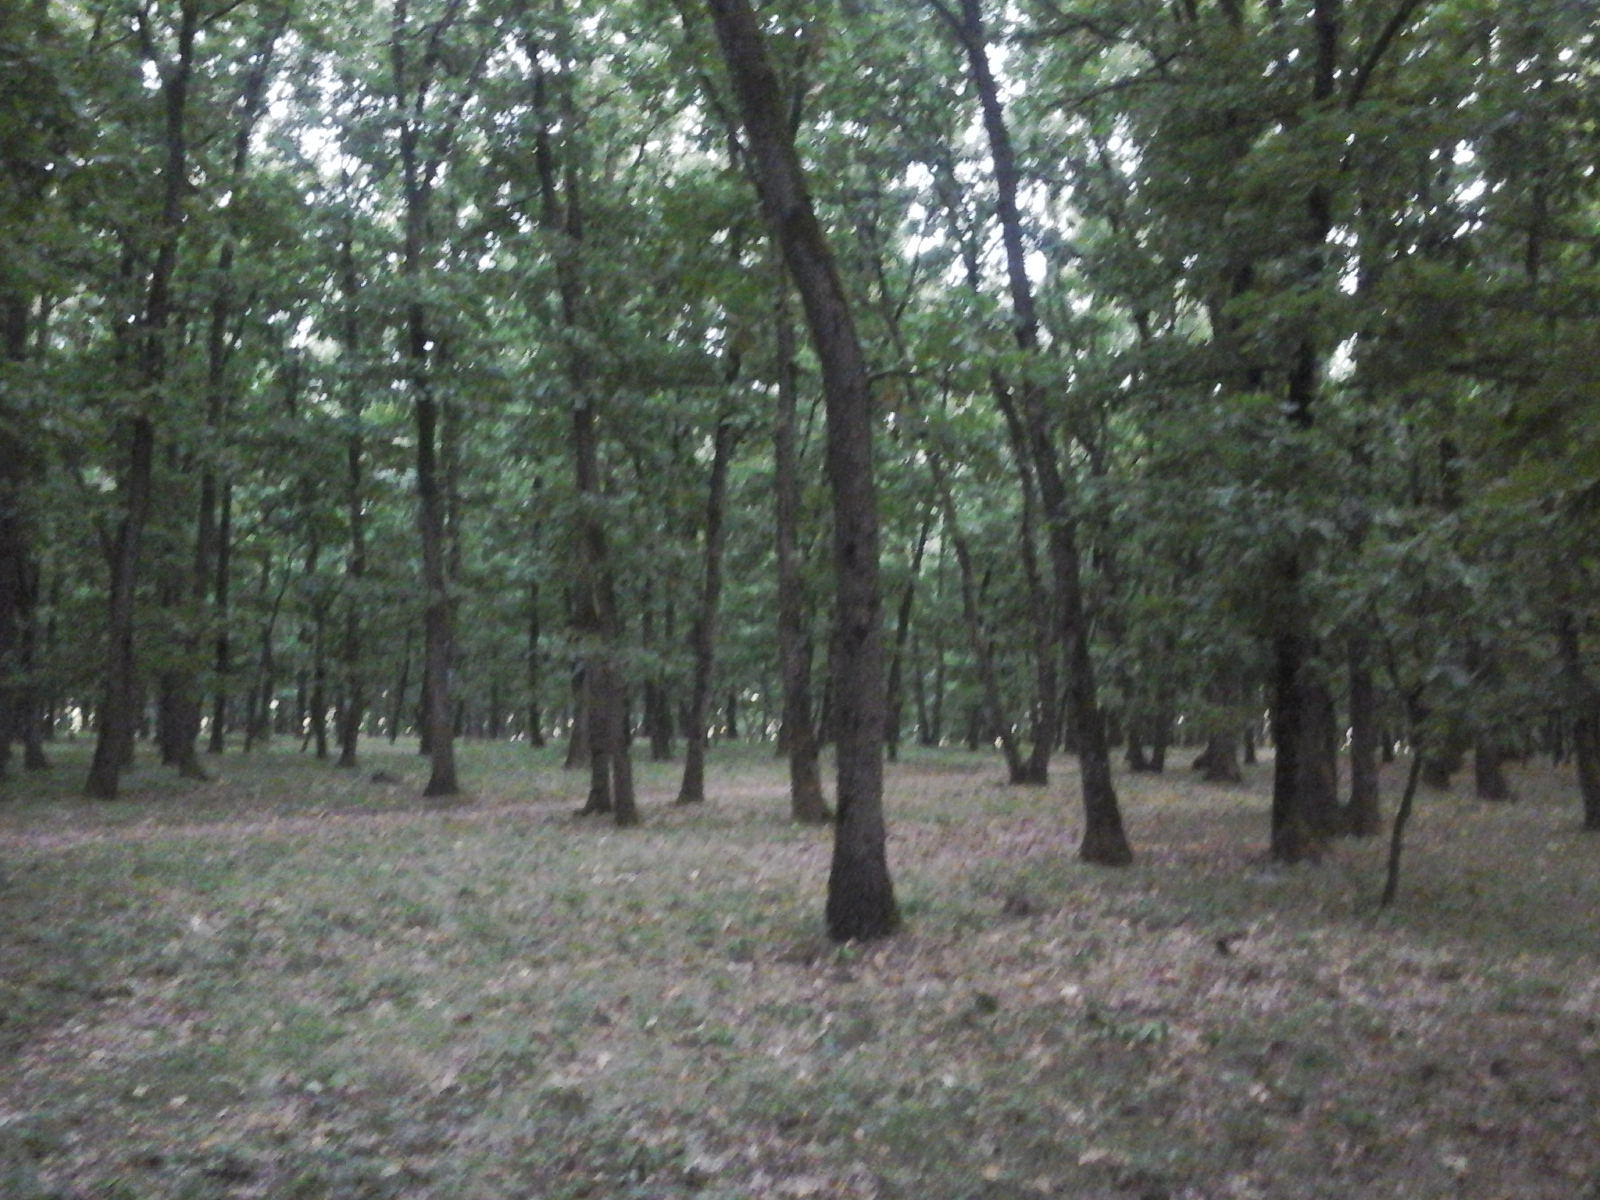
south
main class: Woodland
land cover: Broadleaved woodland
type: acidophilous oak and oak-birch forest
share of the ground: > 75 %
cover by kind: broadleaved forest trees 100 %
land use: Forestry
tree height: > 5 m
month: August
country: RO
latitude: 44.3536
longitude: 23.2588
